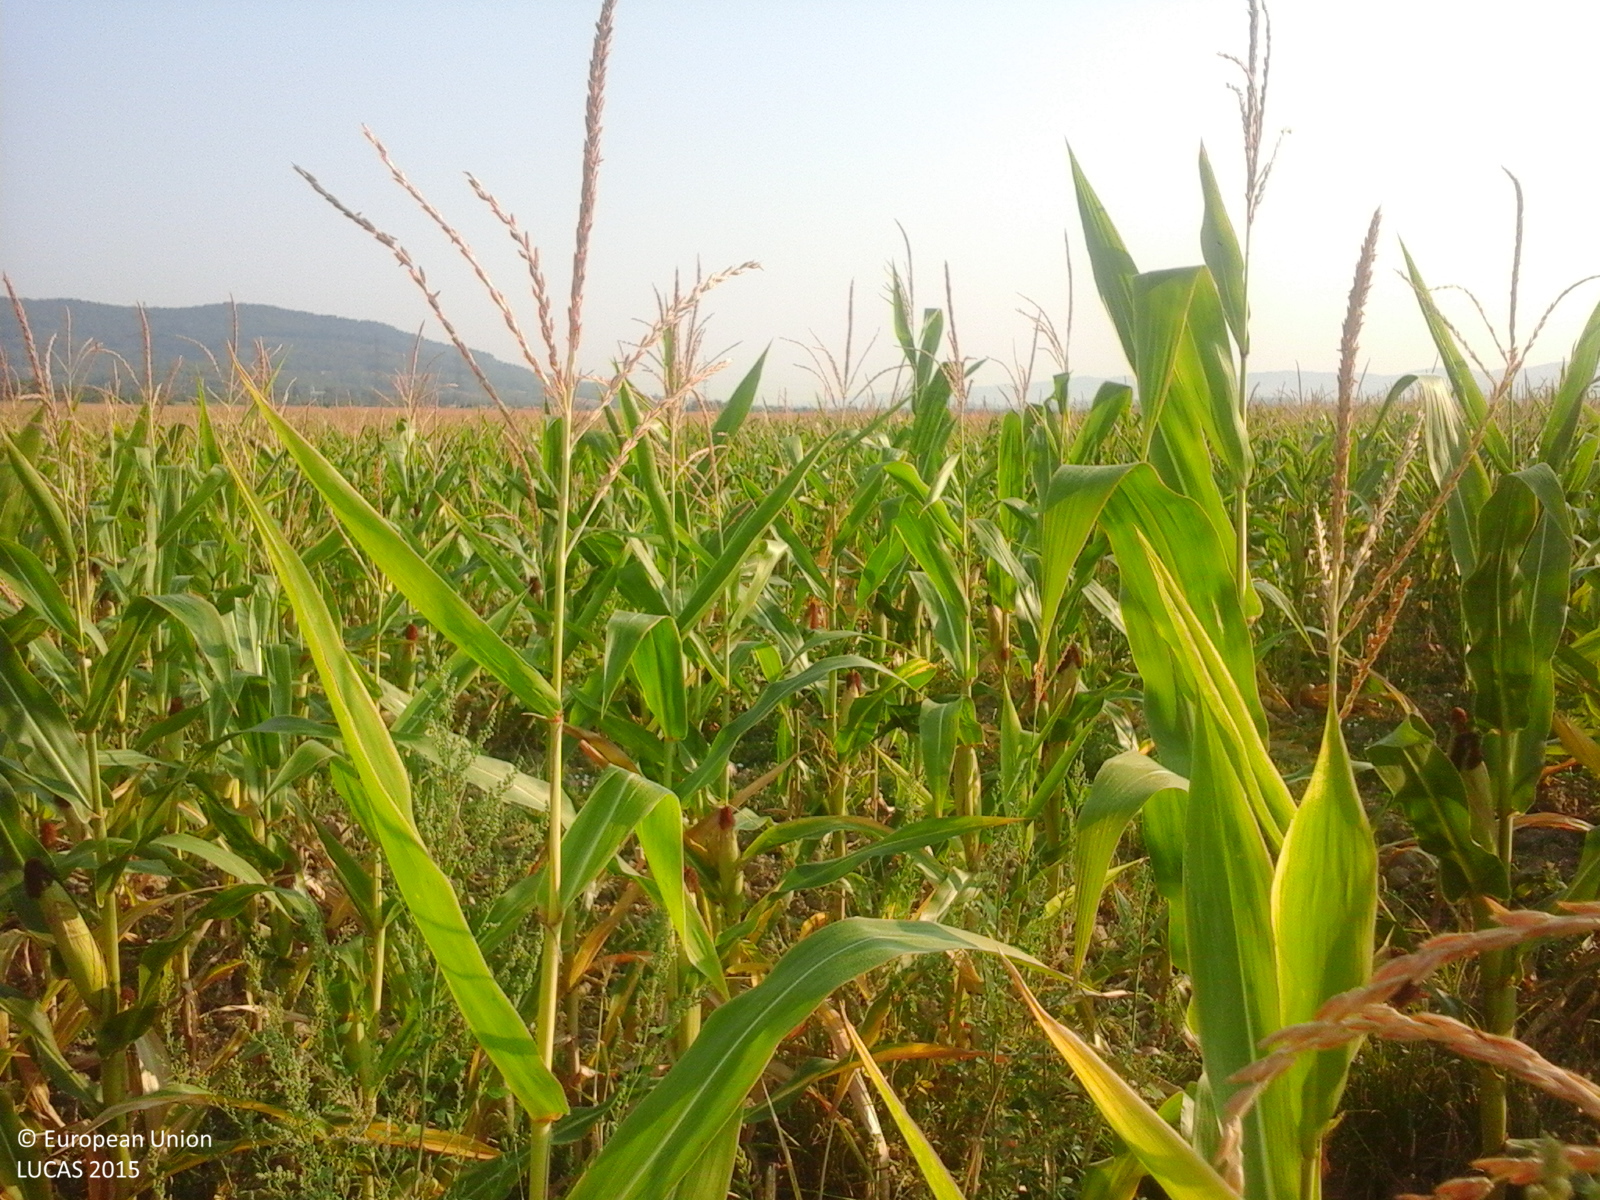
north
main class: Cropland
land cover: Maize
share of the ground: > 75 %
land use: Agriculture (excluding fallow land and kitchen gardens)
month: August
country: RO
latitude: 44.7624
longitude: 23.4849
